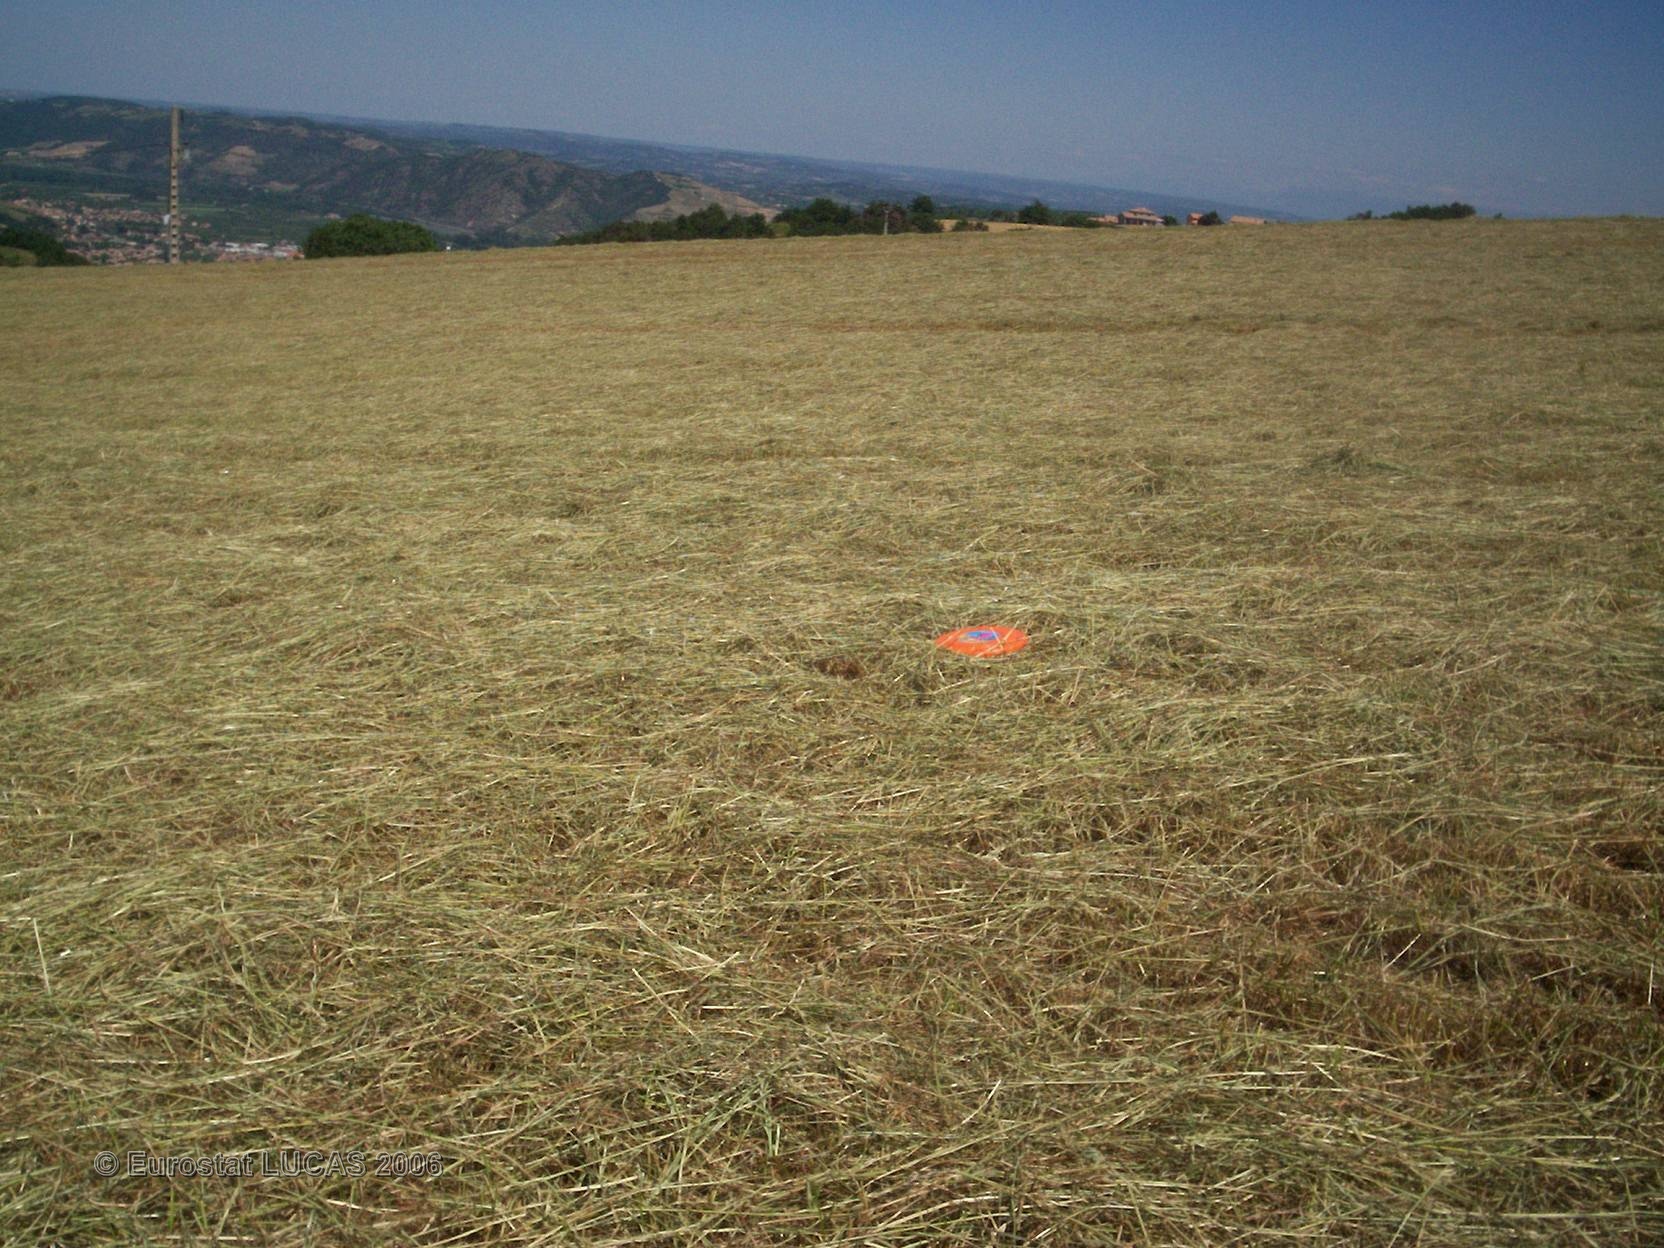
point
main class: Cropland
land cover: Durum wheat
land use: Agriculture (excluding fallow land and kitchen gardens)
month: May
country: FR
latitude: 45.0506
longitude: 4.7868
